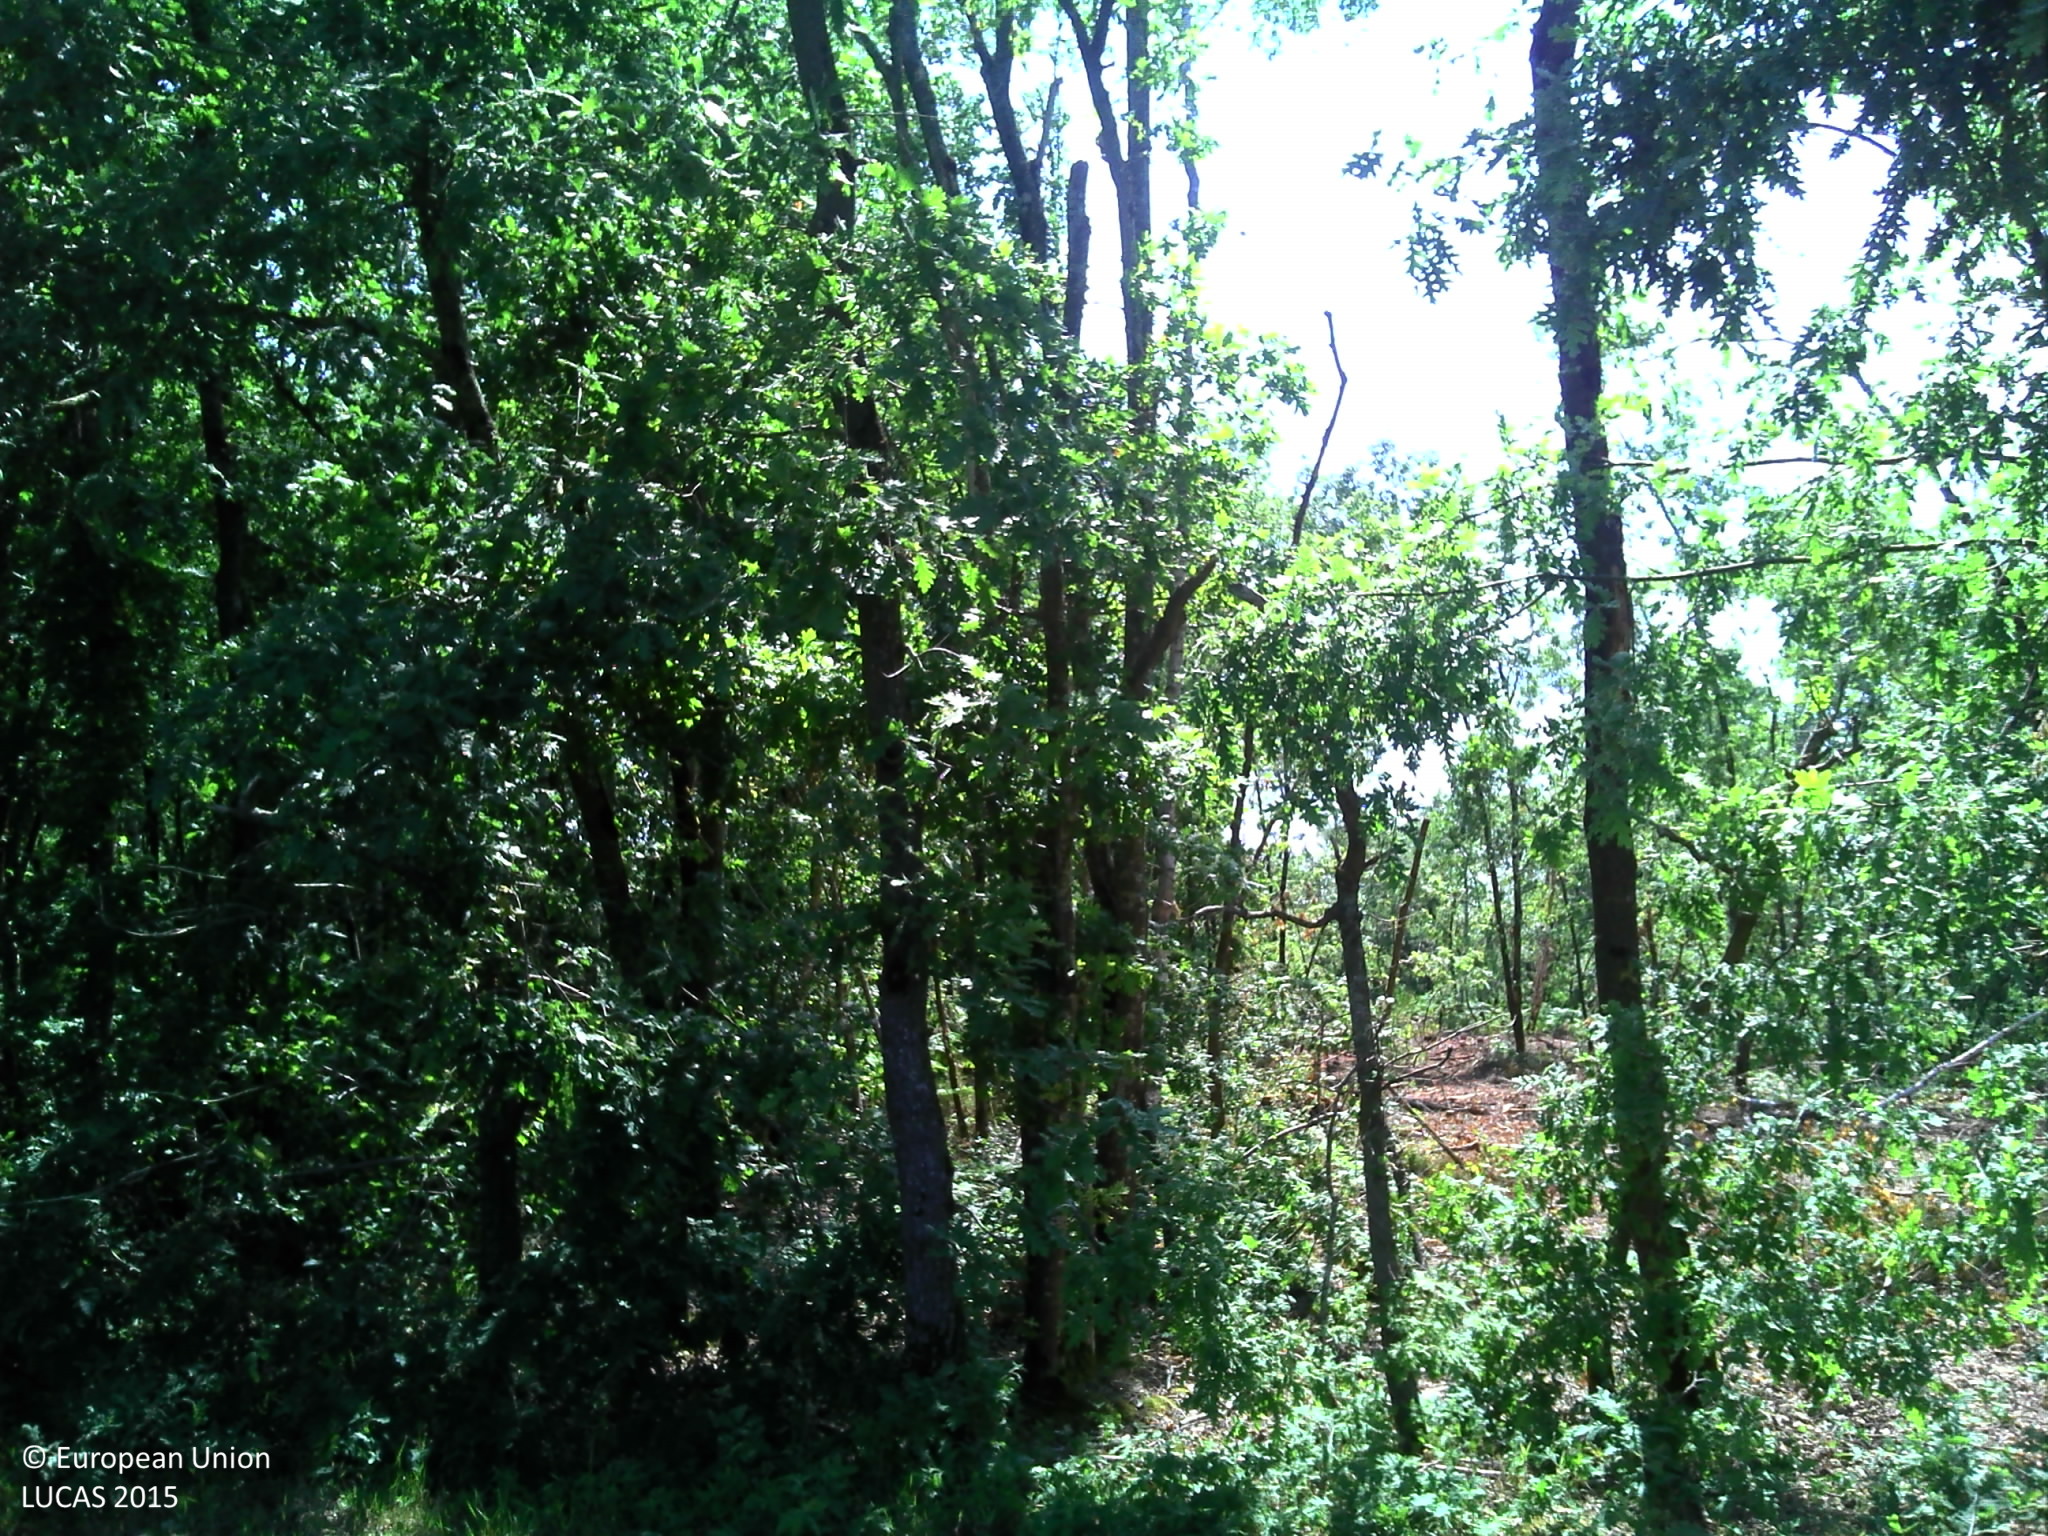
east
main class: Grassland
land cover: Grassland without tree/shrub cover
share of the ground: > 75 %
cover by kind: herbaceous plants 100 %
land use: Agriculture (excluding fallow land and kitchen gardens)
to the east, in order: Grassland without tree/shrub cover; Fences; Grass margins; Paved roads, cycling and walking lanes; Grass margins; Spruce dominated mixed woodland; Tracks; Spruce dominated mixed woodland
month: June
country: FR
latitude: 47.6946
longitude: -0.0068
